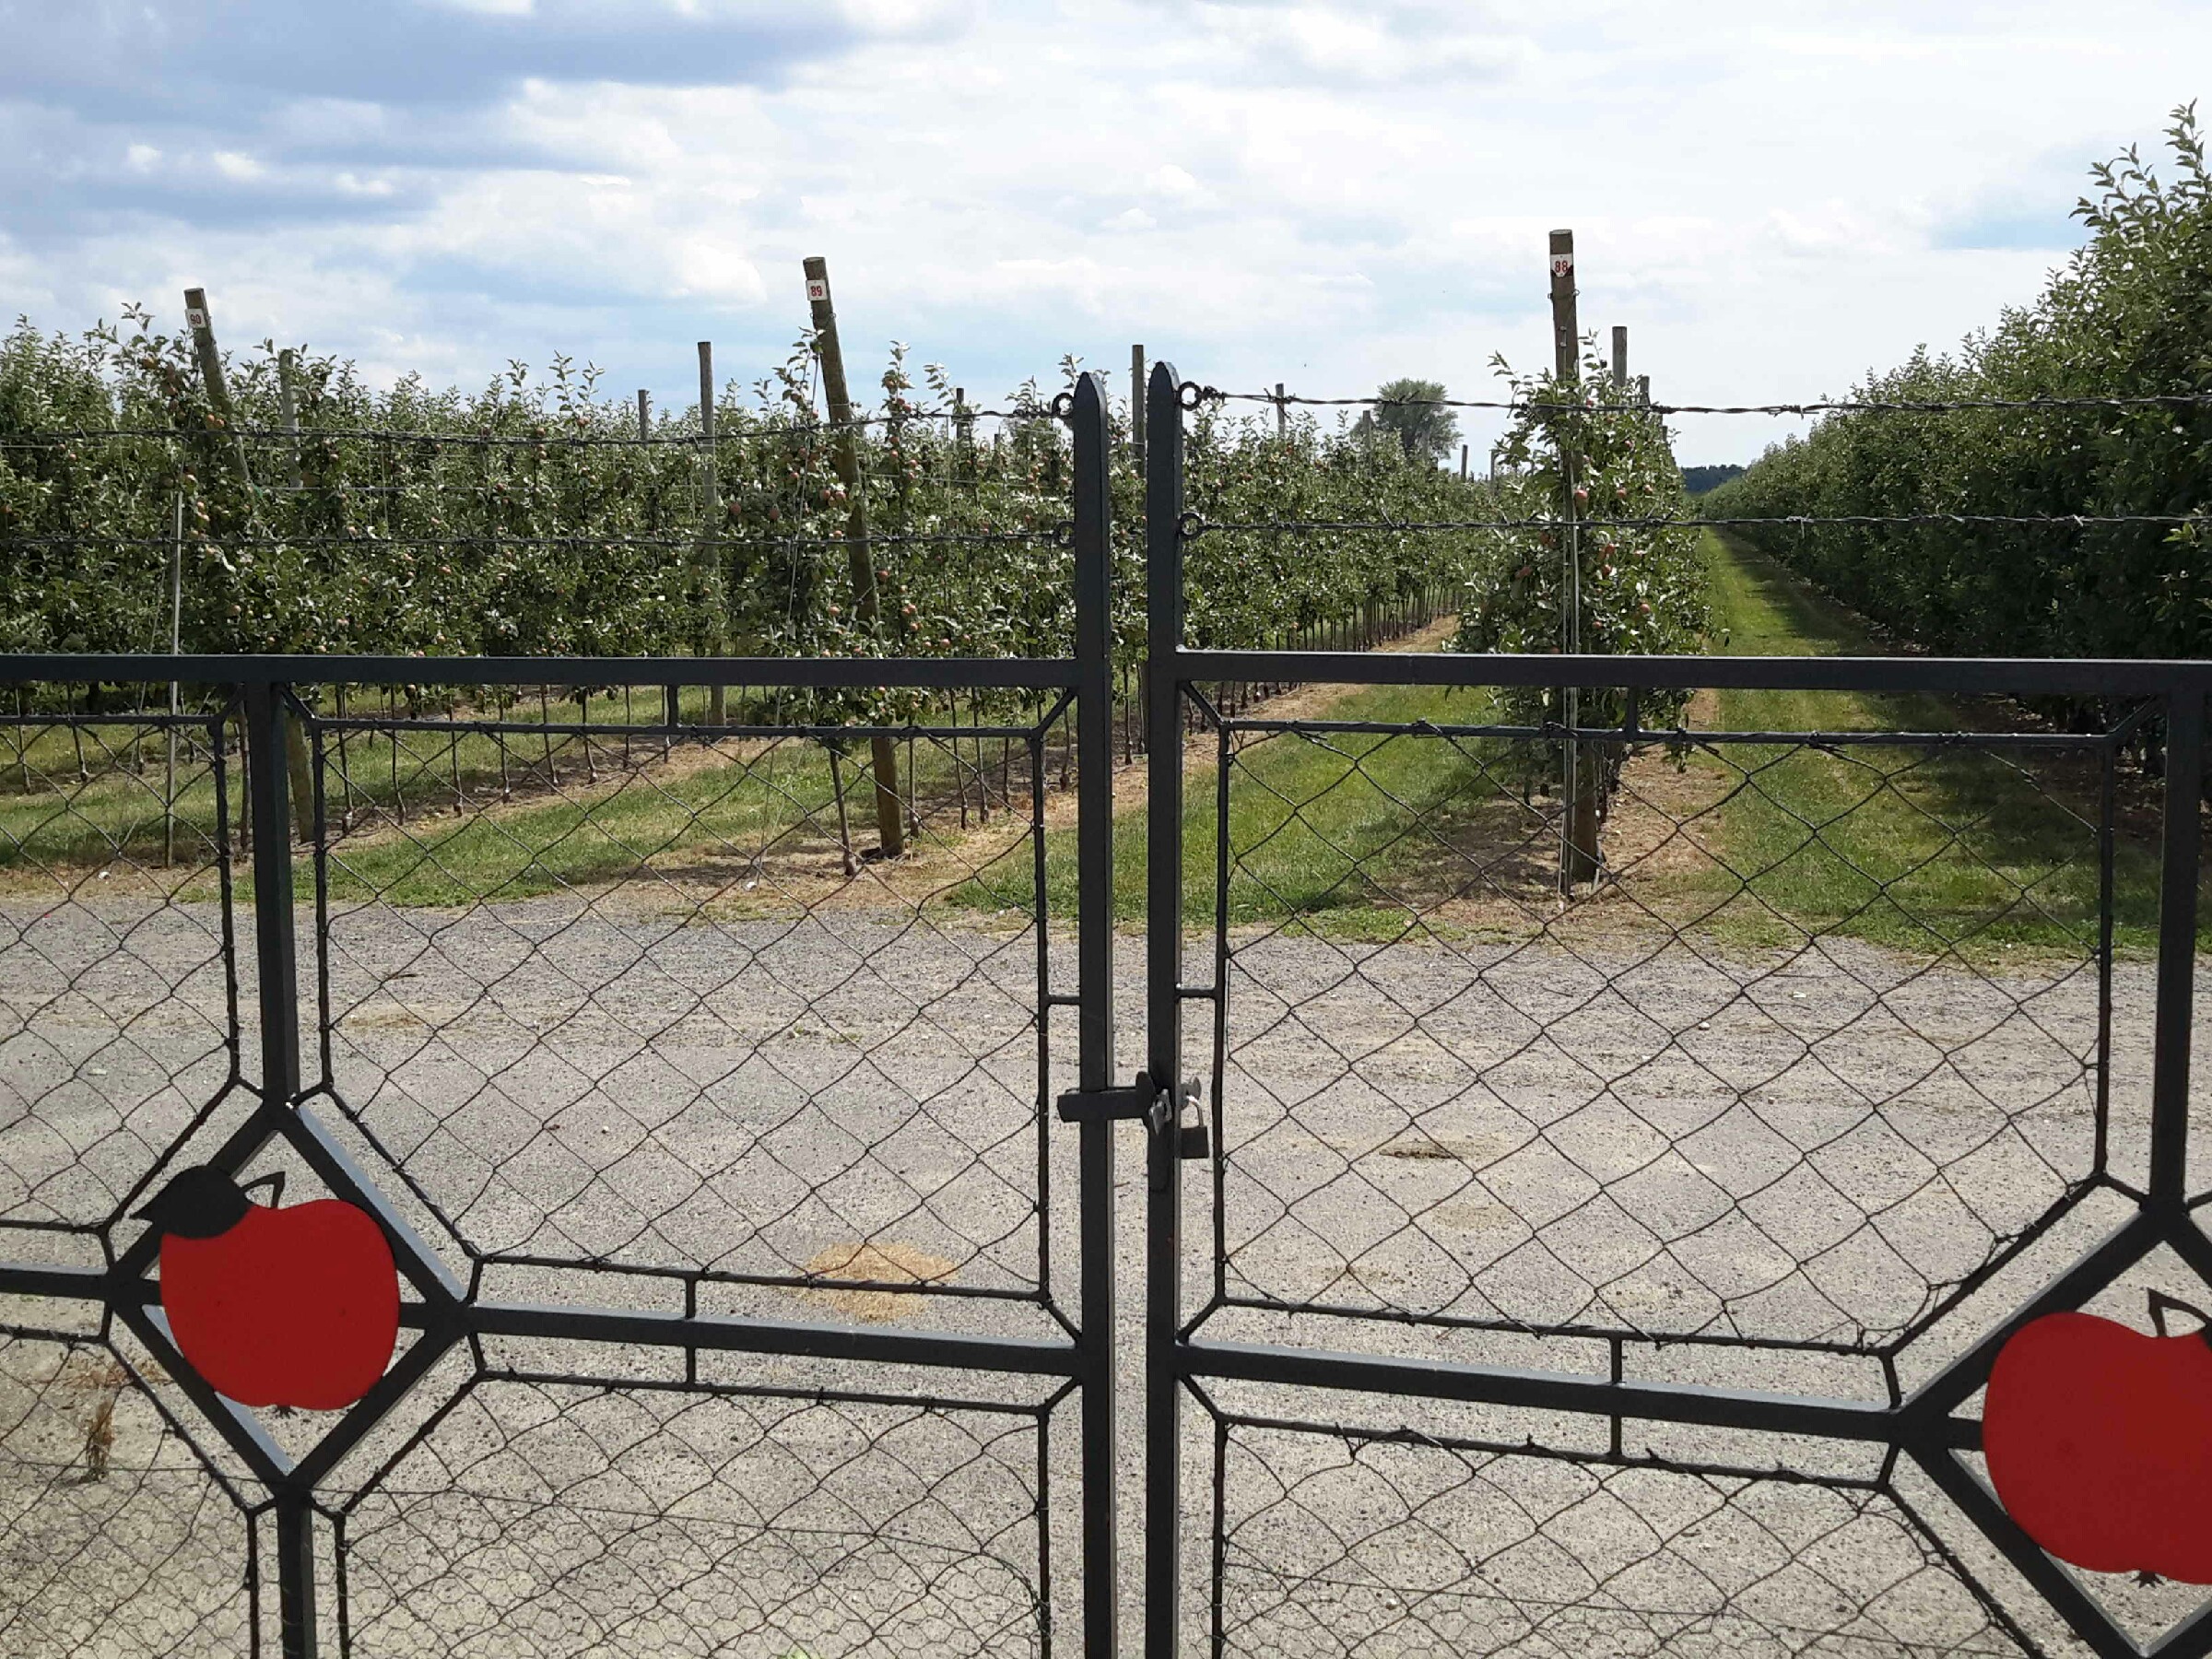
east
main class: Cropland
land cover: Apple fruit
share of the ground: 25 - 50 %
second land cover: Grassland without tree/shrub cover
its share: 50 - 75 %
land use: Agriculture (excluding fallow land and kitchen gardens)
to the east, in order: Apple fruit; Grassland without tree/shrub cover
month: July
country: HU
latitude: 47.5350
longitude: 17.2200
